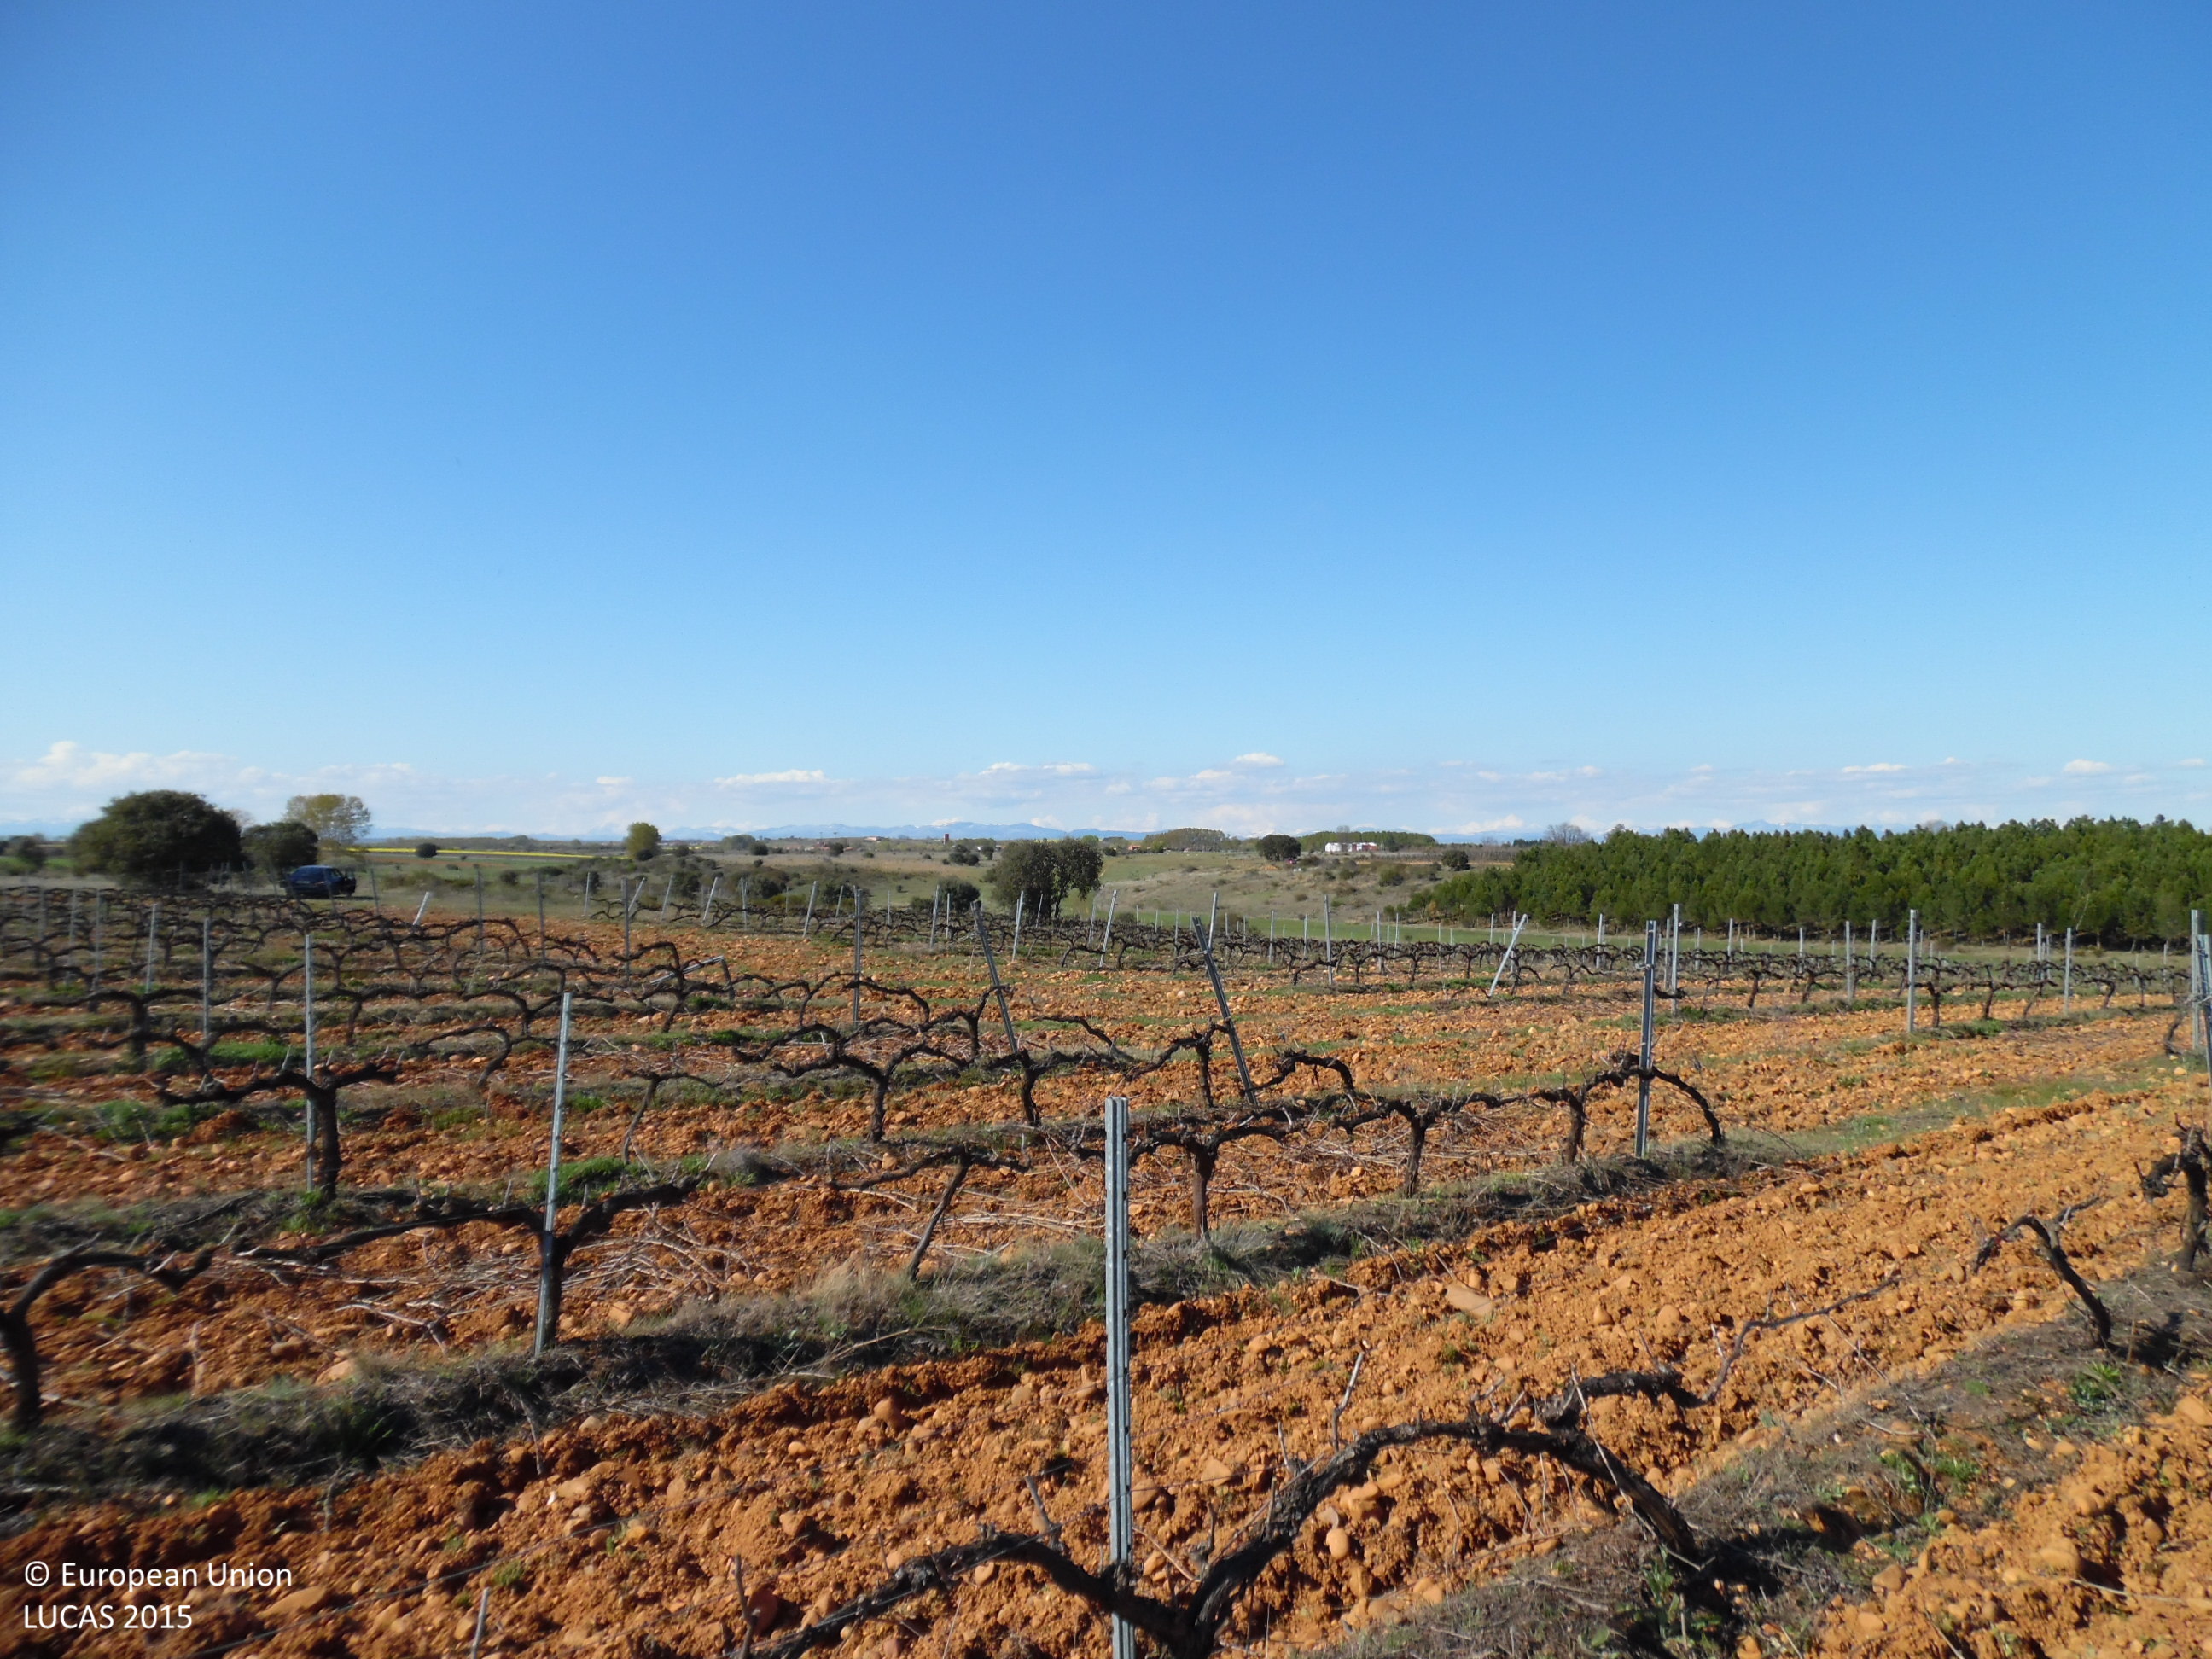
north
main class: Cropland
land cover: Vineyards
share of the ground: < 10 %
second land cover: Other bare soil
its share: > 75 %
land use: Agriculture (excluding fallow land and kitchen gardens)
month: April
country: ES
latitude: 42.4884
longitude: -5.6831
